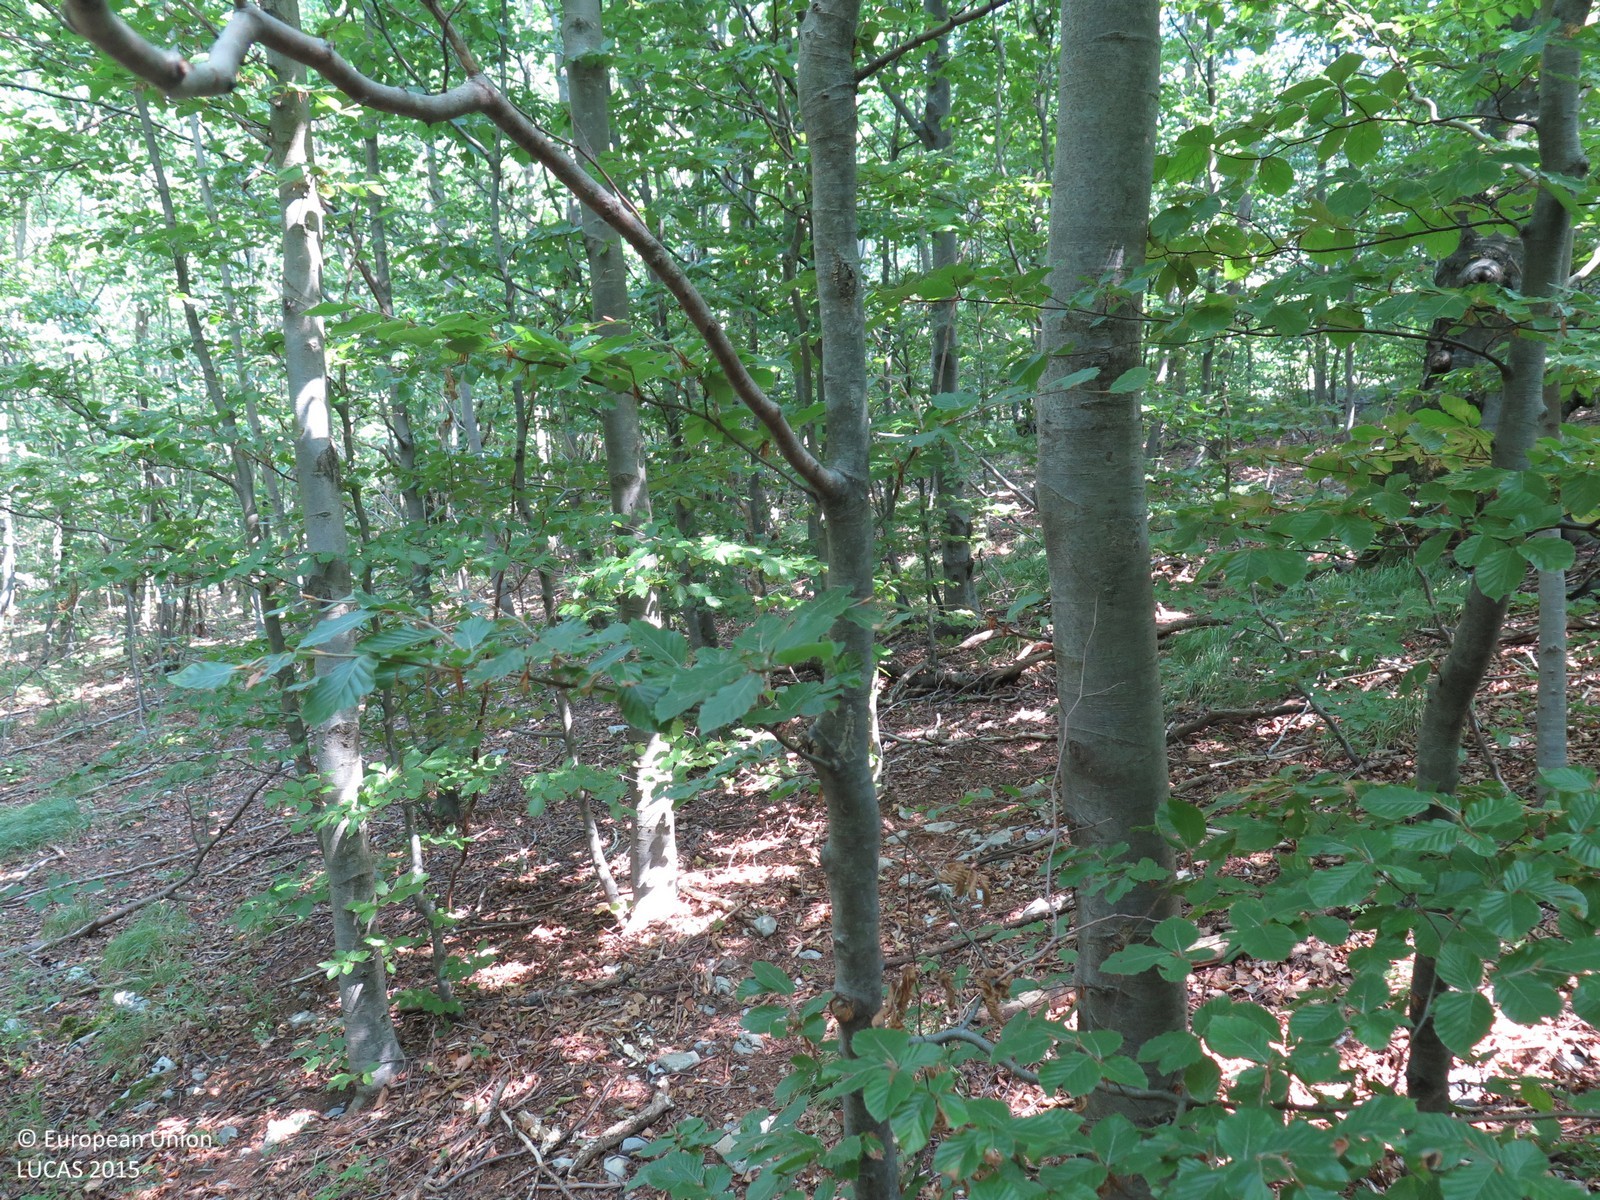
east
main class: Woodland
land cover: Broadleaved woodland
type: beech forest
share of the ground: > 75 %
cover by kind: broadleaved forest trees 90 %, herbaceous plants 5 %, unconsolidated bare surface 5 %
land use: Forestry
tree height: > 5 m
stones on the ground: 10 - 25 %
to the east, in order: Broadleaved woodland; Dry stone walls; Broadleaved woodland
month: August
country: HR
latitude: 45.3679
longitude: 14.6043
